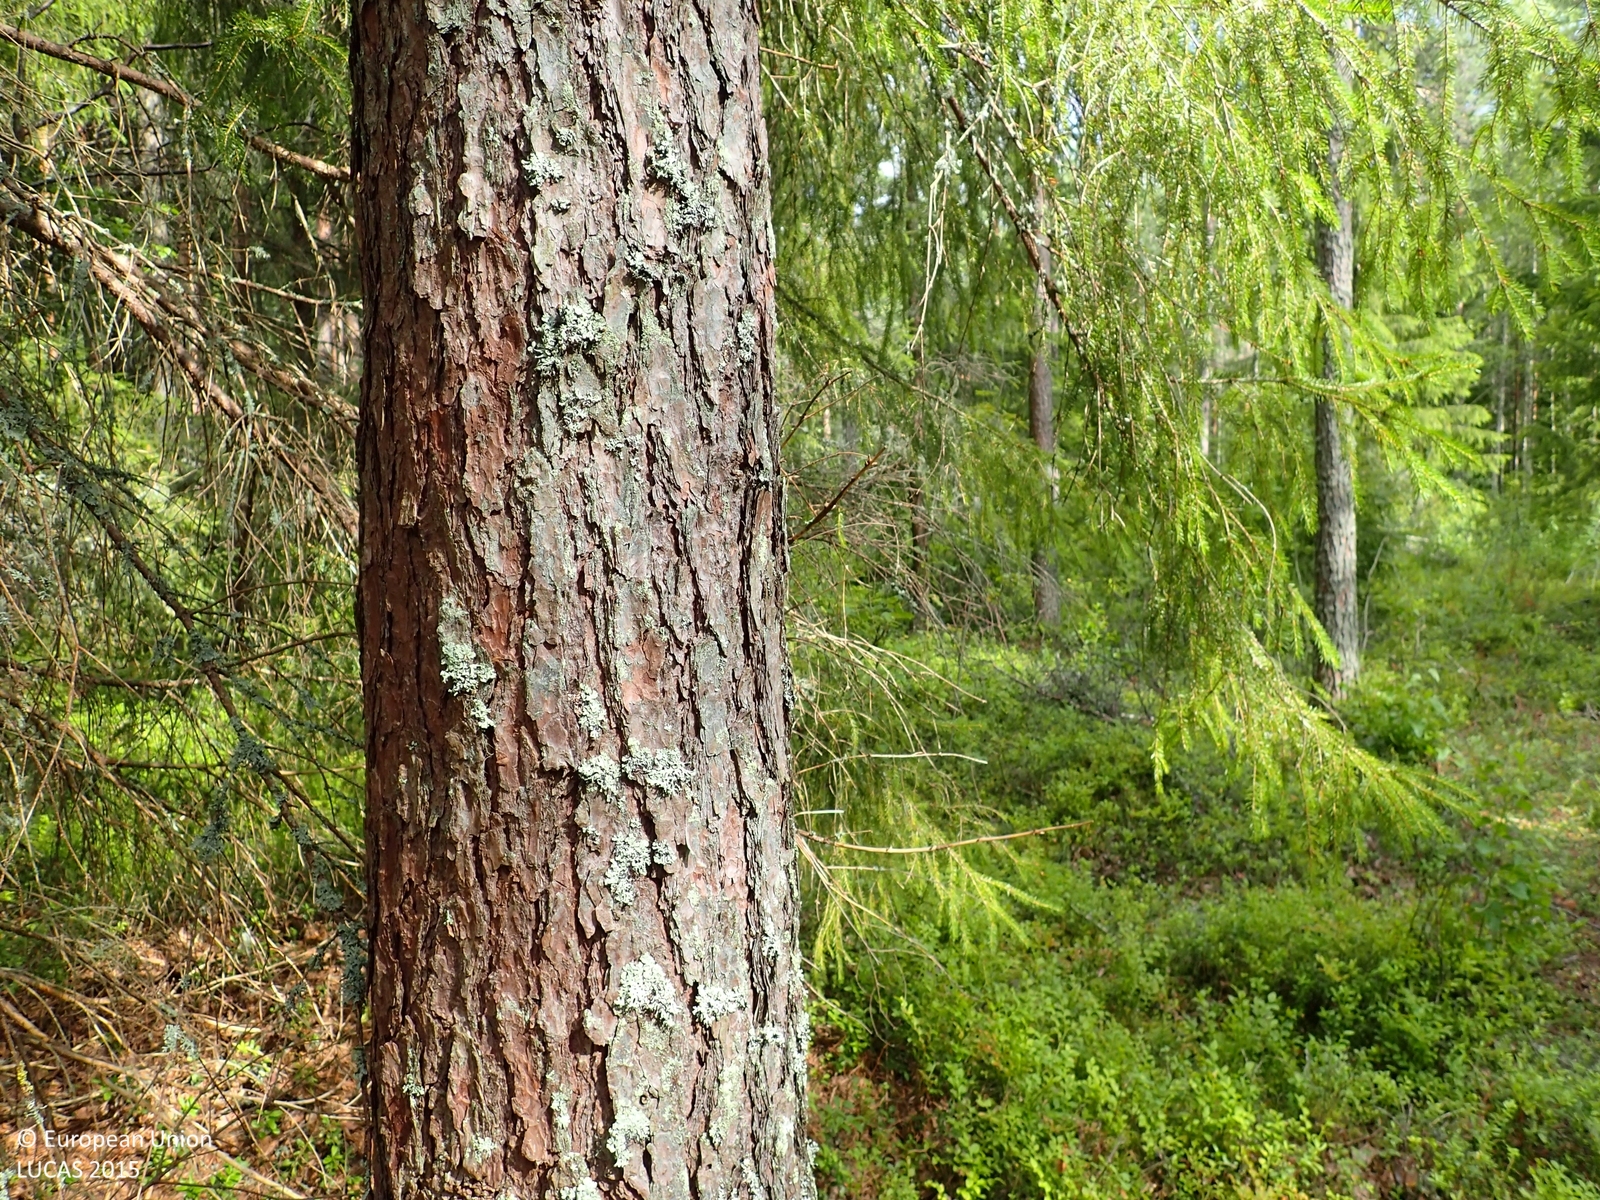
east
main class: Woodland
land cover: Other coniferous woodland
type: boreal forest
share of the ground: > 75 %
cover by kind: coniferous forest trees 70 %, shrubs 20 %, broadleaved forest trees 10 %
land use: Forestry
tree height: > 5 m
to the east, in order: Other coniferous woodland; Tracks; Ditches and canals; Pine dominated coniferous woodland; Pine dominated mixed woodland; Ditches and canals; Spruce dominated mixed woodland; Other mixed woodland
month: August
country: FI
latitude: 62.6364
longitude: 21.8447
